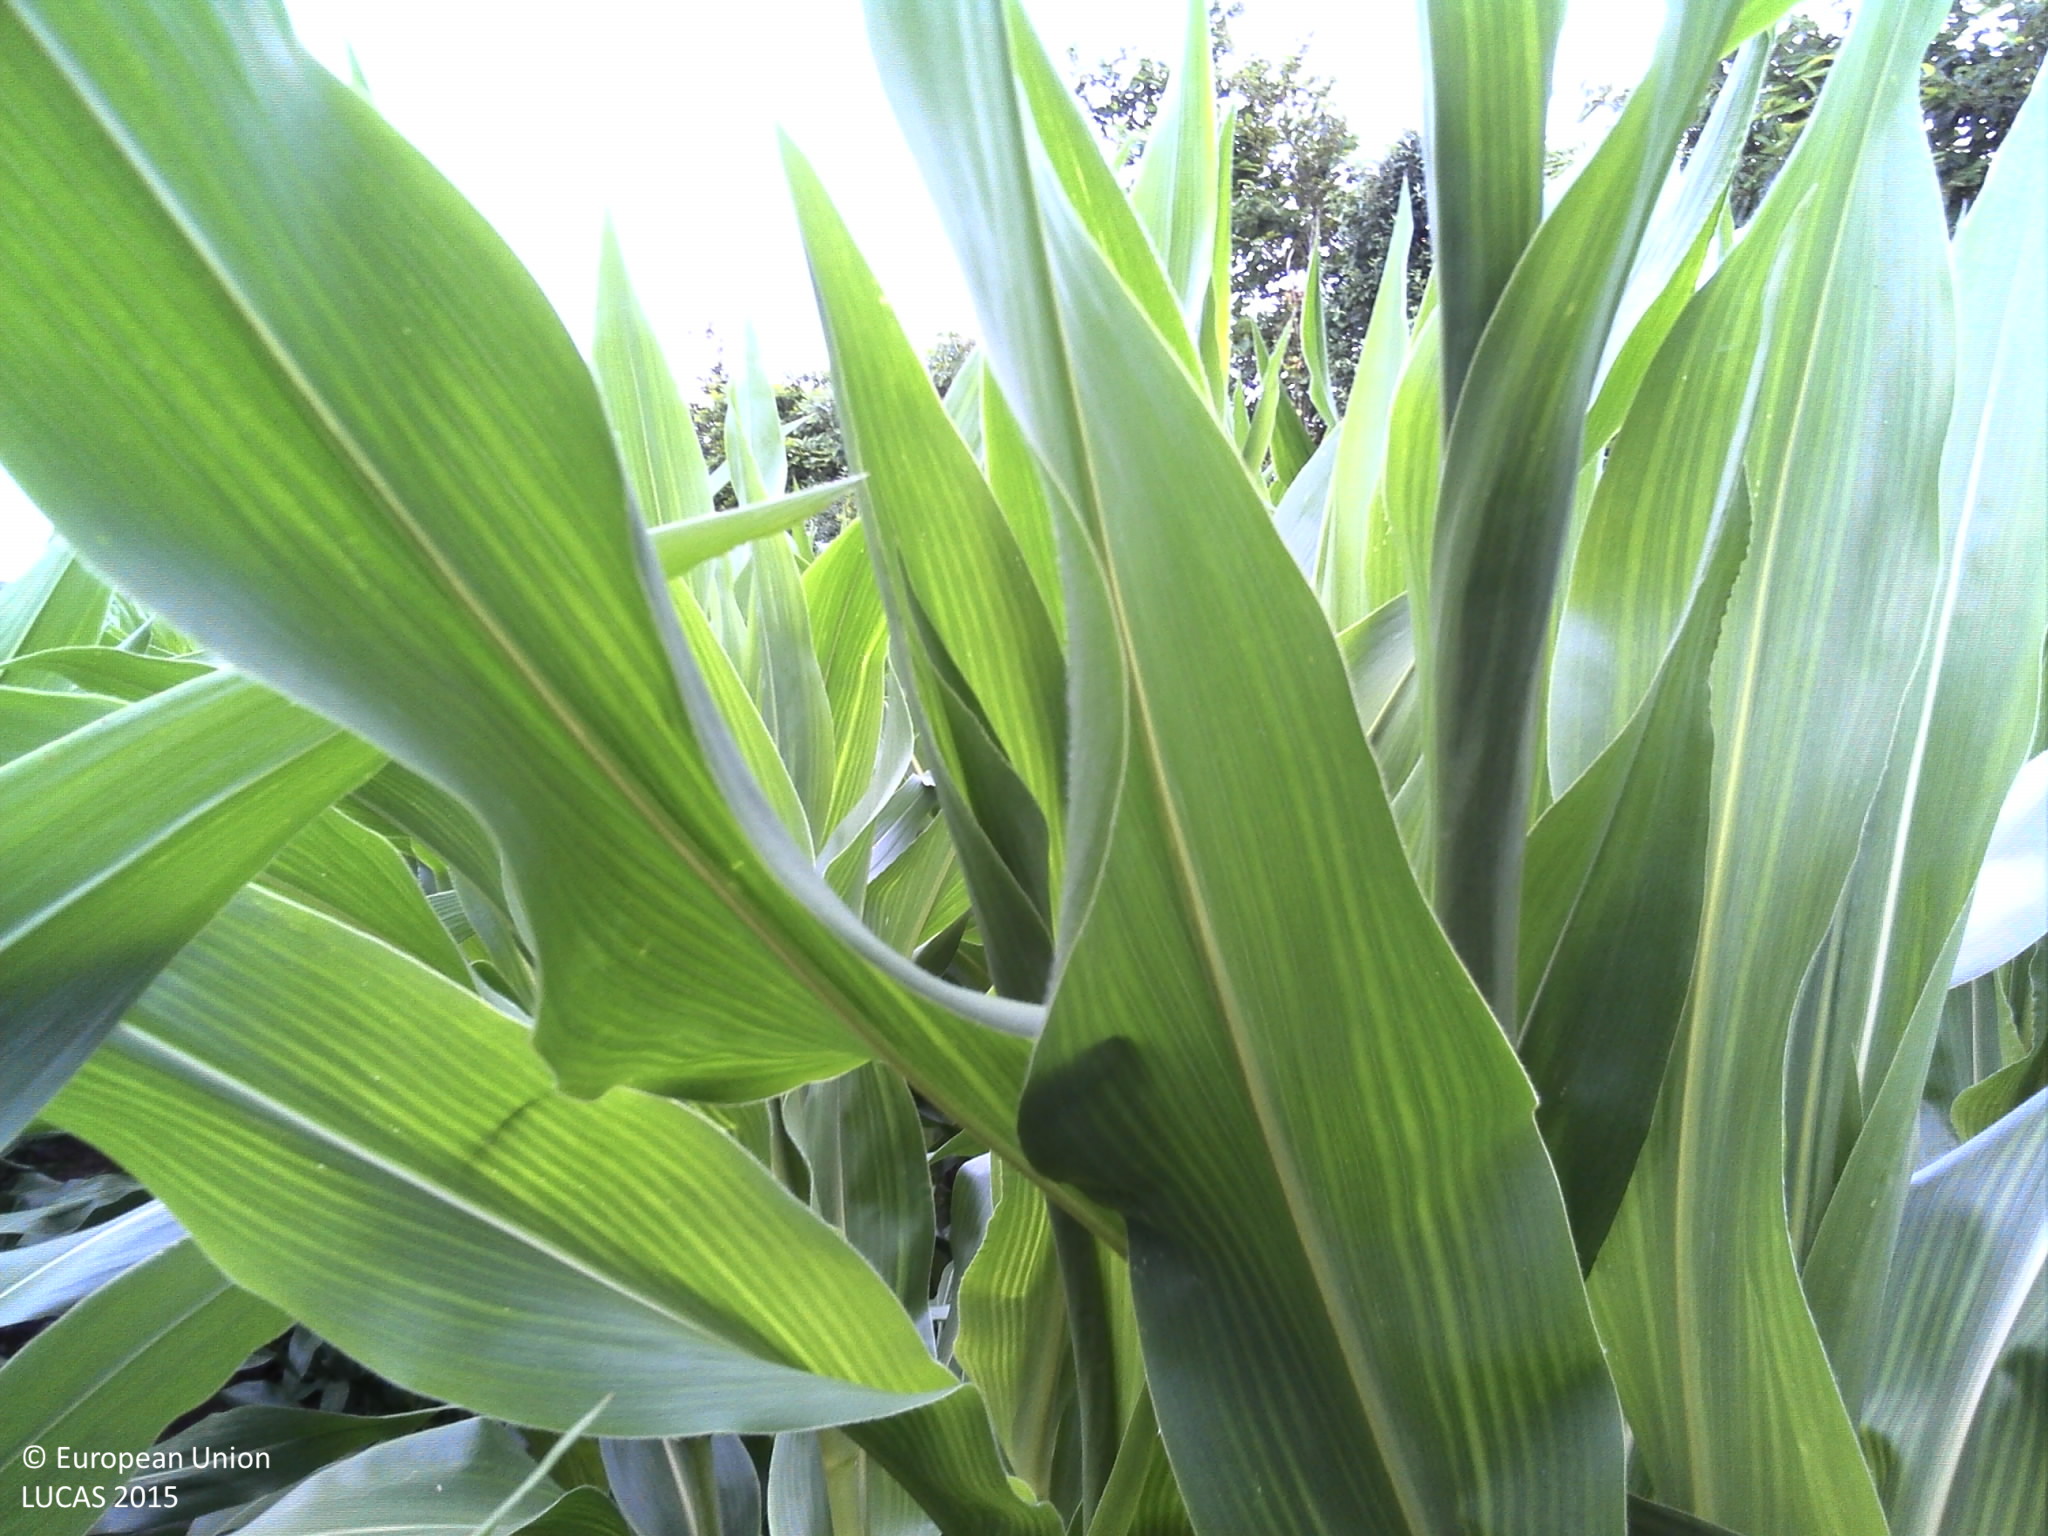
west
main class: Cropland
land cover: Maize
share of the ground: > 75 %
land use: Agriculture (excluding fallow land and kitchen gardens)
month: July
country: FR
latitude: 48.4610
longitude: -4.5289
